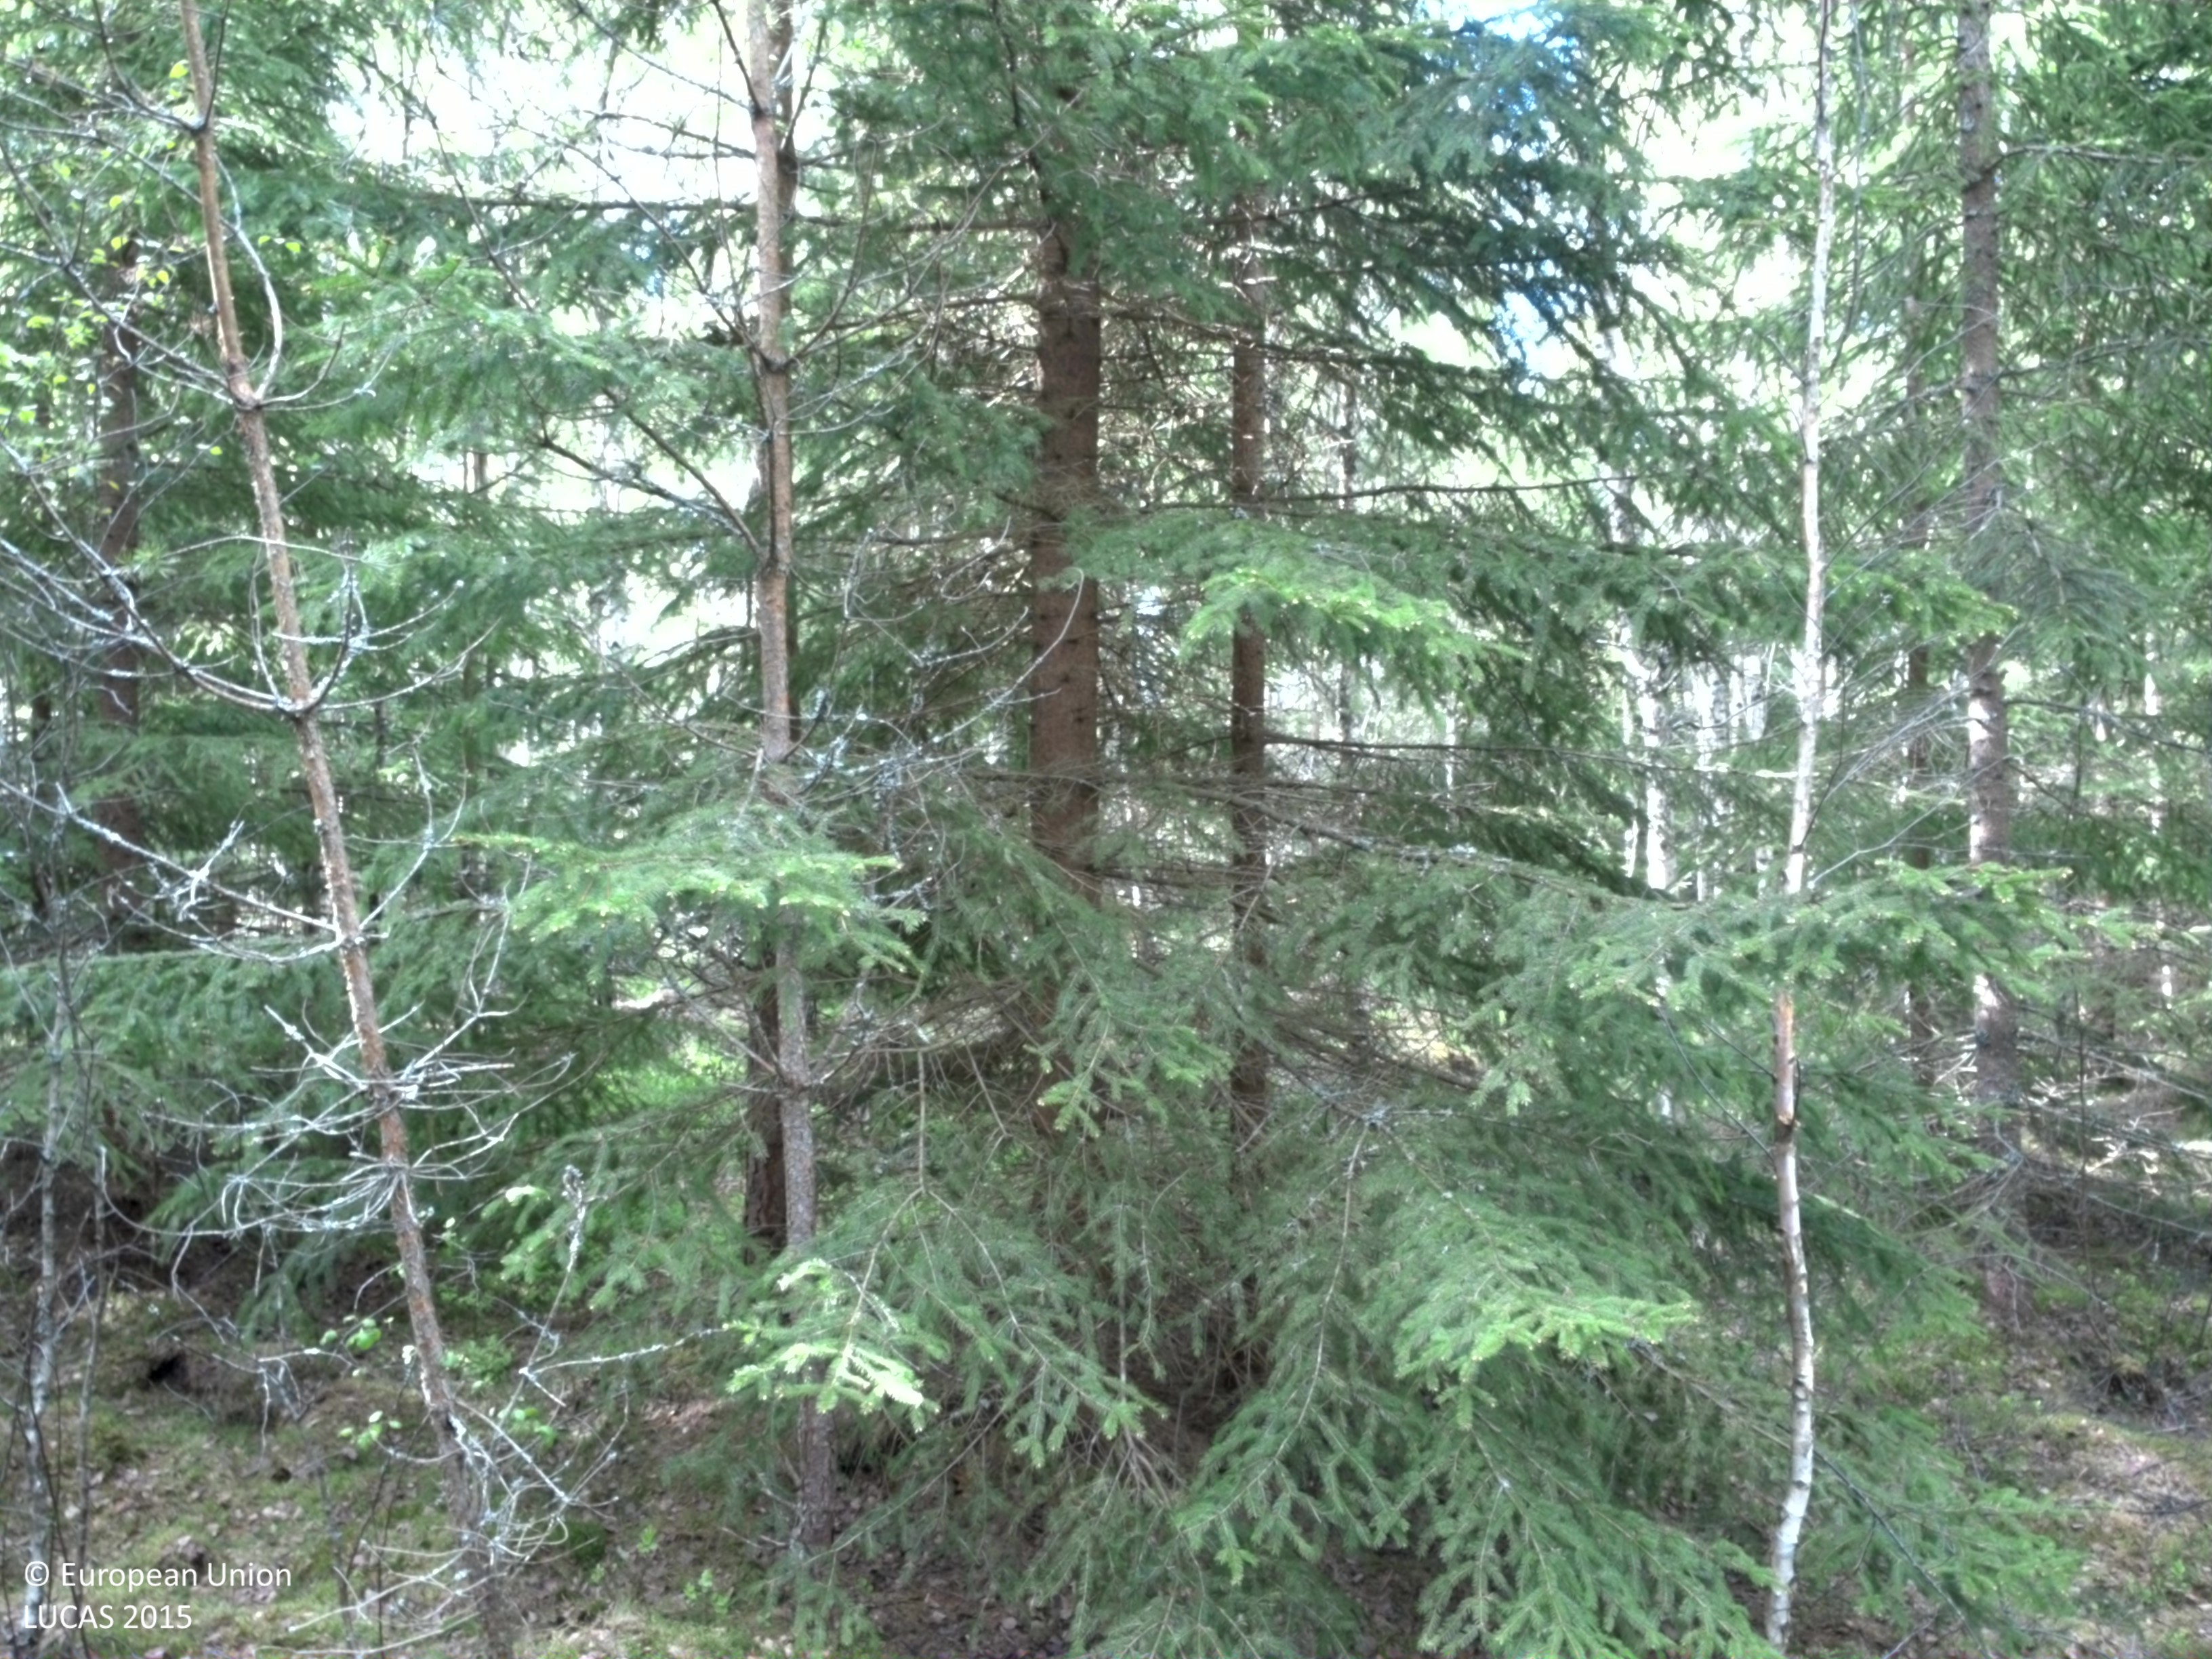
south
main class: Woodland
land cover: Spruce dominated mixed woodland
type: boreal forest
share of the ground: > 75 %
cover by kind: coniferous forest trees 40 %, broadleaved forest trees 40 %, lichens and mosses 20 %
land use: Forestry
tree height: > 5 m
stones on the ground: 10 - 25 %
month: May
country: SE
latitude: 56.7254
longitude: 15.3422
